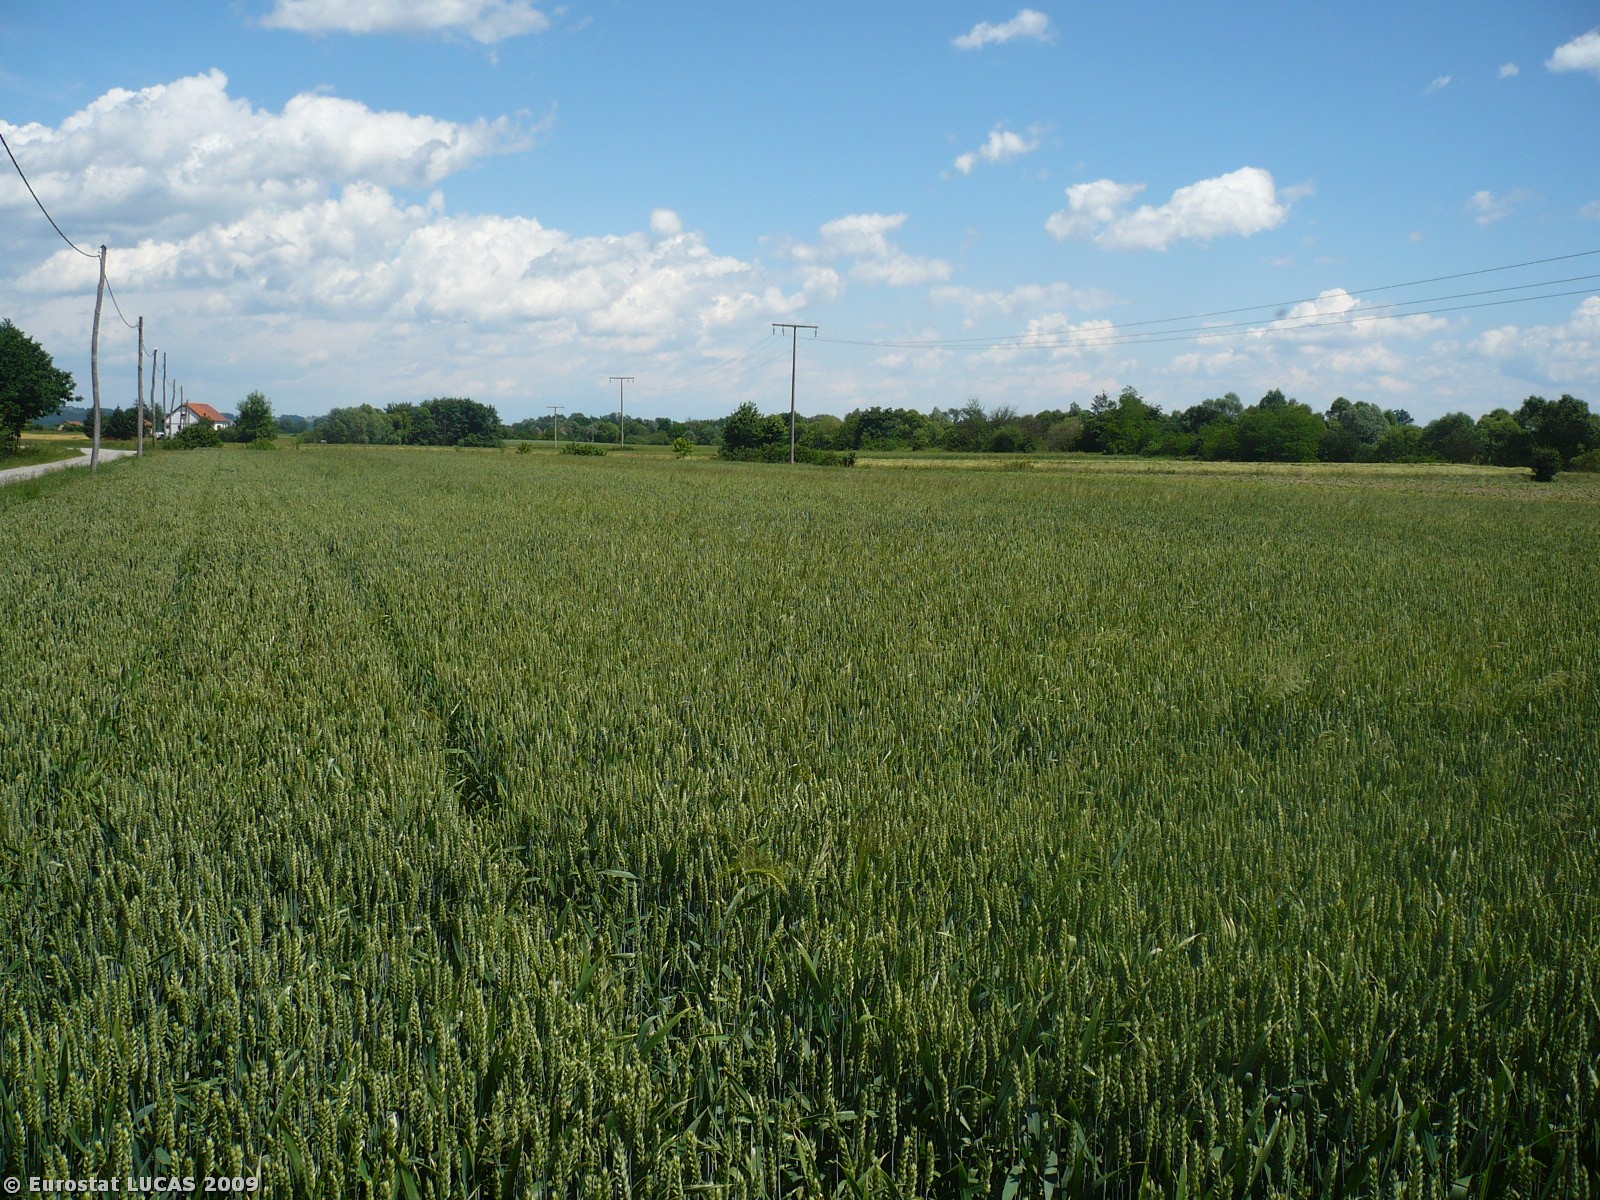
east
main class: Cropland
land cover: Common wheat
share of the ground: > 75 %
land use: Agriculture (excluding fallow land and kitchen gardens)
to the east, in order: Common wheat; Grass margins; Ditches and canals; Grass margins; Barley; Grass margins; Barley; Grass margins; Maize; Grassland without tree/shrub cover; Common wheat; Grassland without tree/shrub cover; Maize
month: May
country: SI
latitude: 46.4162
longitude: 16.0234
